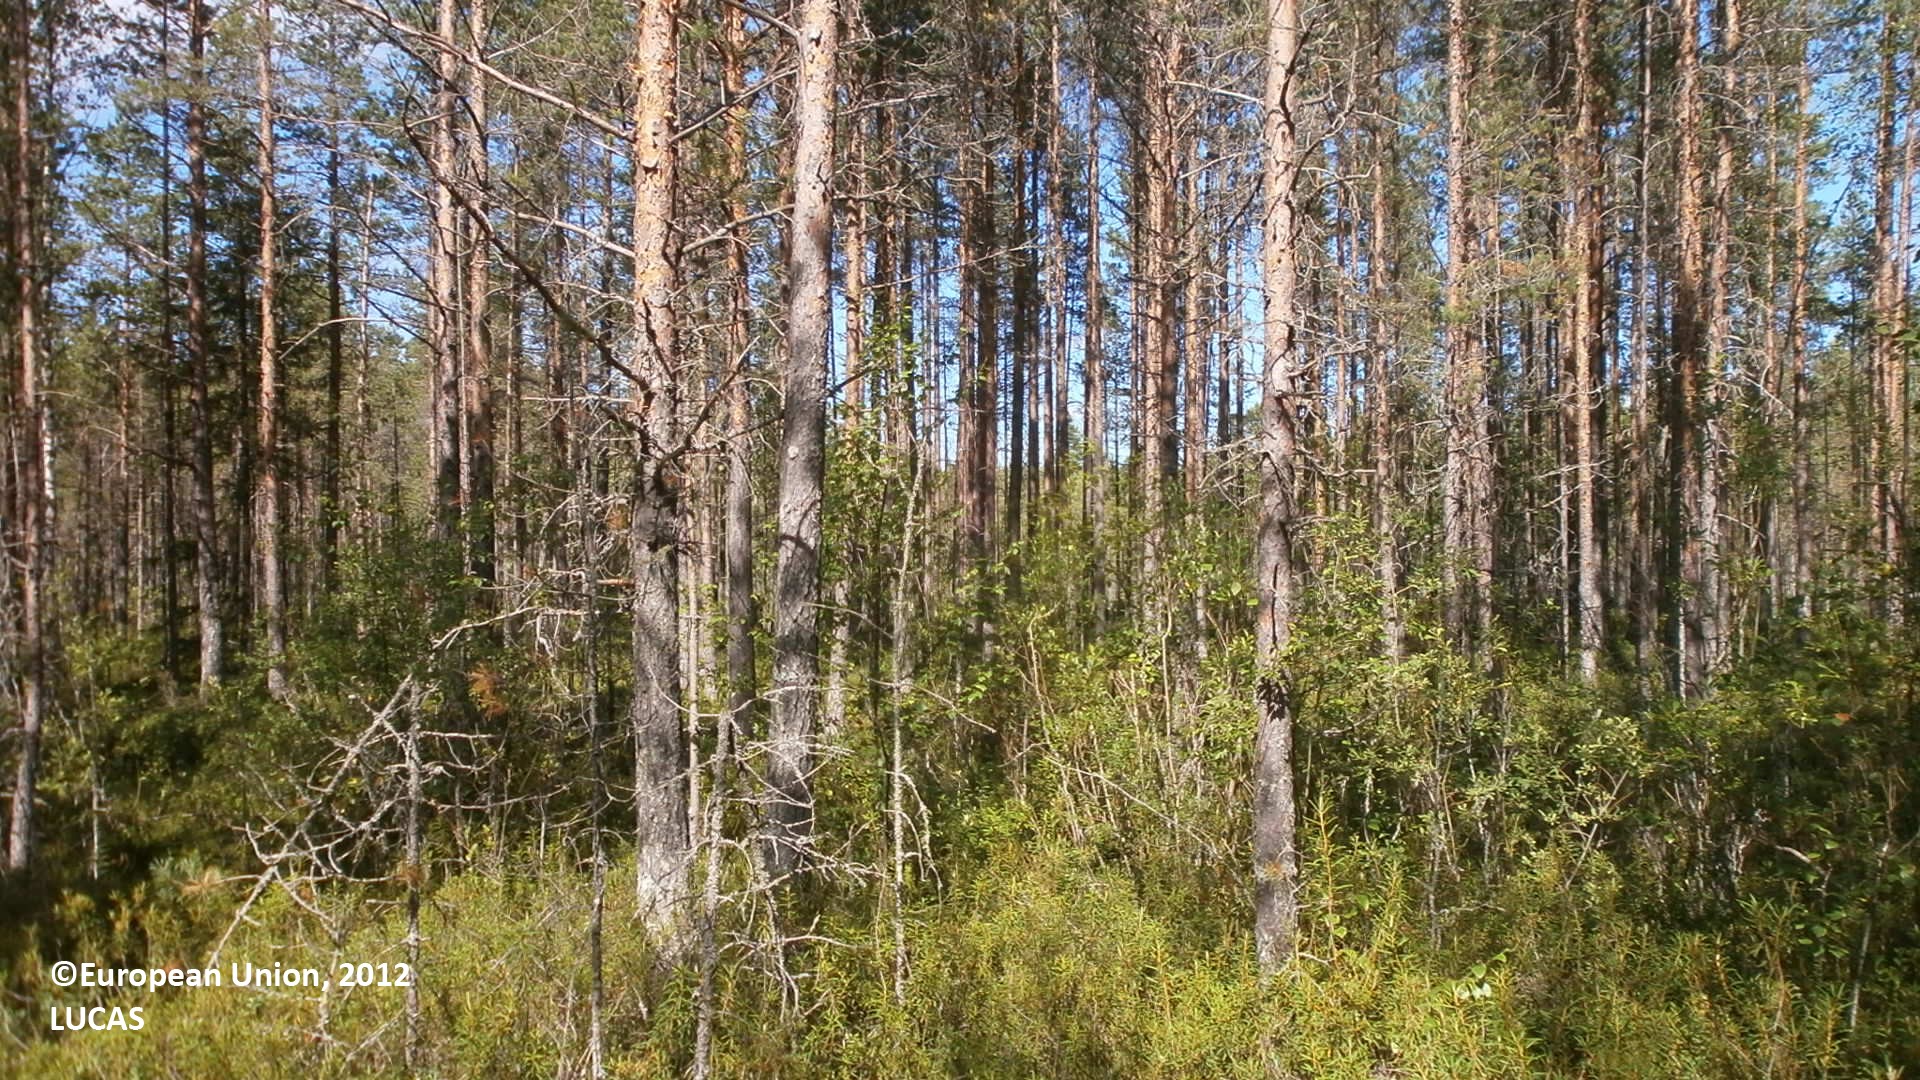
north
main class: Woodland
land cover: Pine dominated coniferous woodland
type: mire and swamp forests
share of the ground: 50 - 75 %
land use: Forestry
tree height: > 5 m
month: July
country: FI
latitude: 64.1462
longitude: 24.3548
